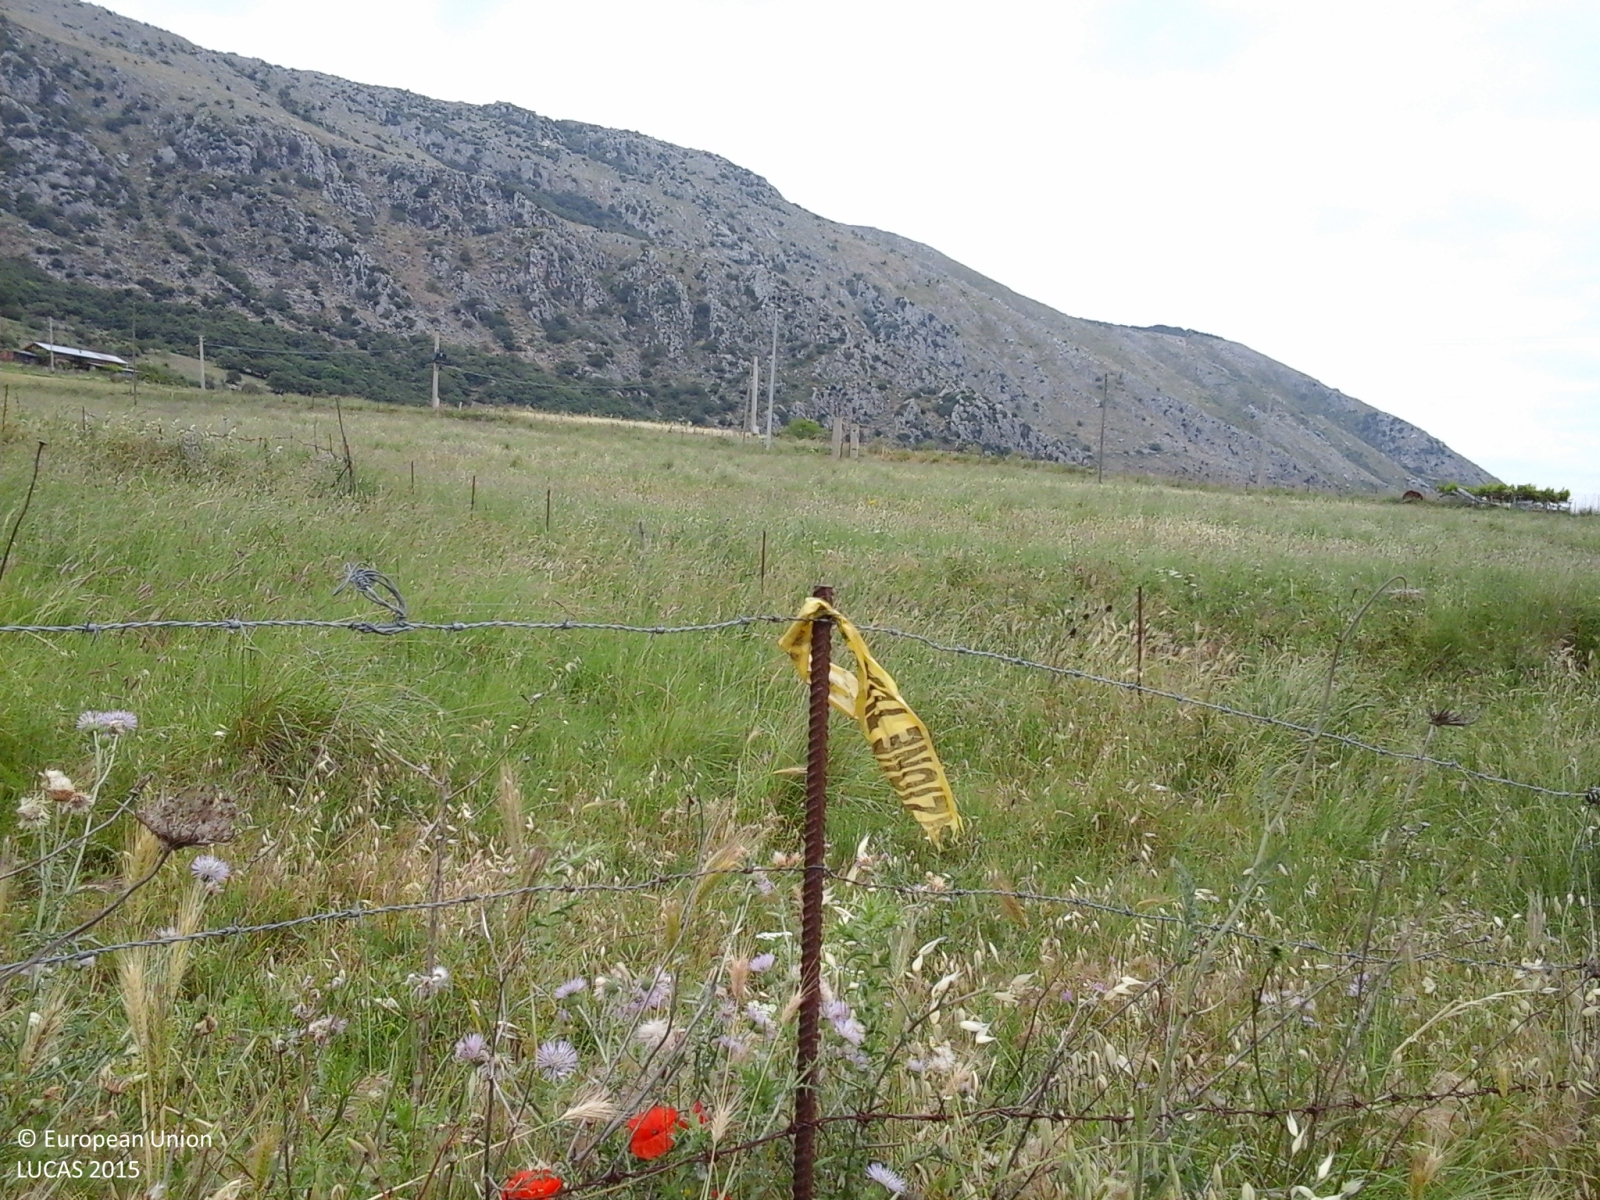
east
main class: Cropland
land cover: Other leguminous and mixtures for fodder
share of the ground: > 75 %
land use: Agriculture (excluding fallow land and kitchen gardens)
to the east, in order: Other leguminous and mixtures for fodder; Grassland without tree/shrub cover; Other leguminous and mixtures for fodder; Fences; Tracks; Fences; Other leguminous and mixtures for fodder; Electric lines; Other leguminous and mixtures for fodder; Fences; Tracks; Fences; Spontaneously vegetated surfaces; Electric lines; Fences; Spontaneously vegetated surfaces
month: May
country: IT
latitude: 37.9353
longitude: 13.5587
